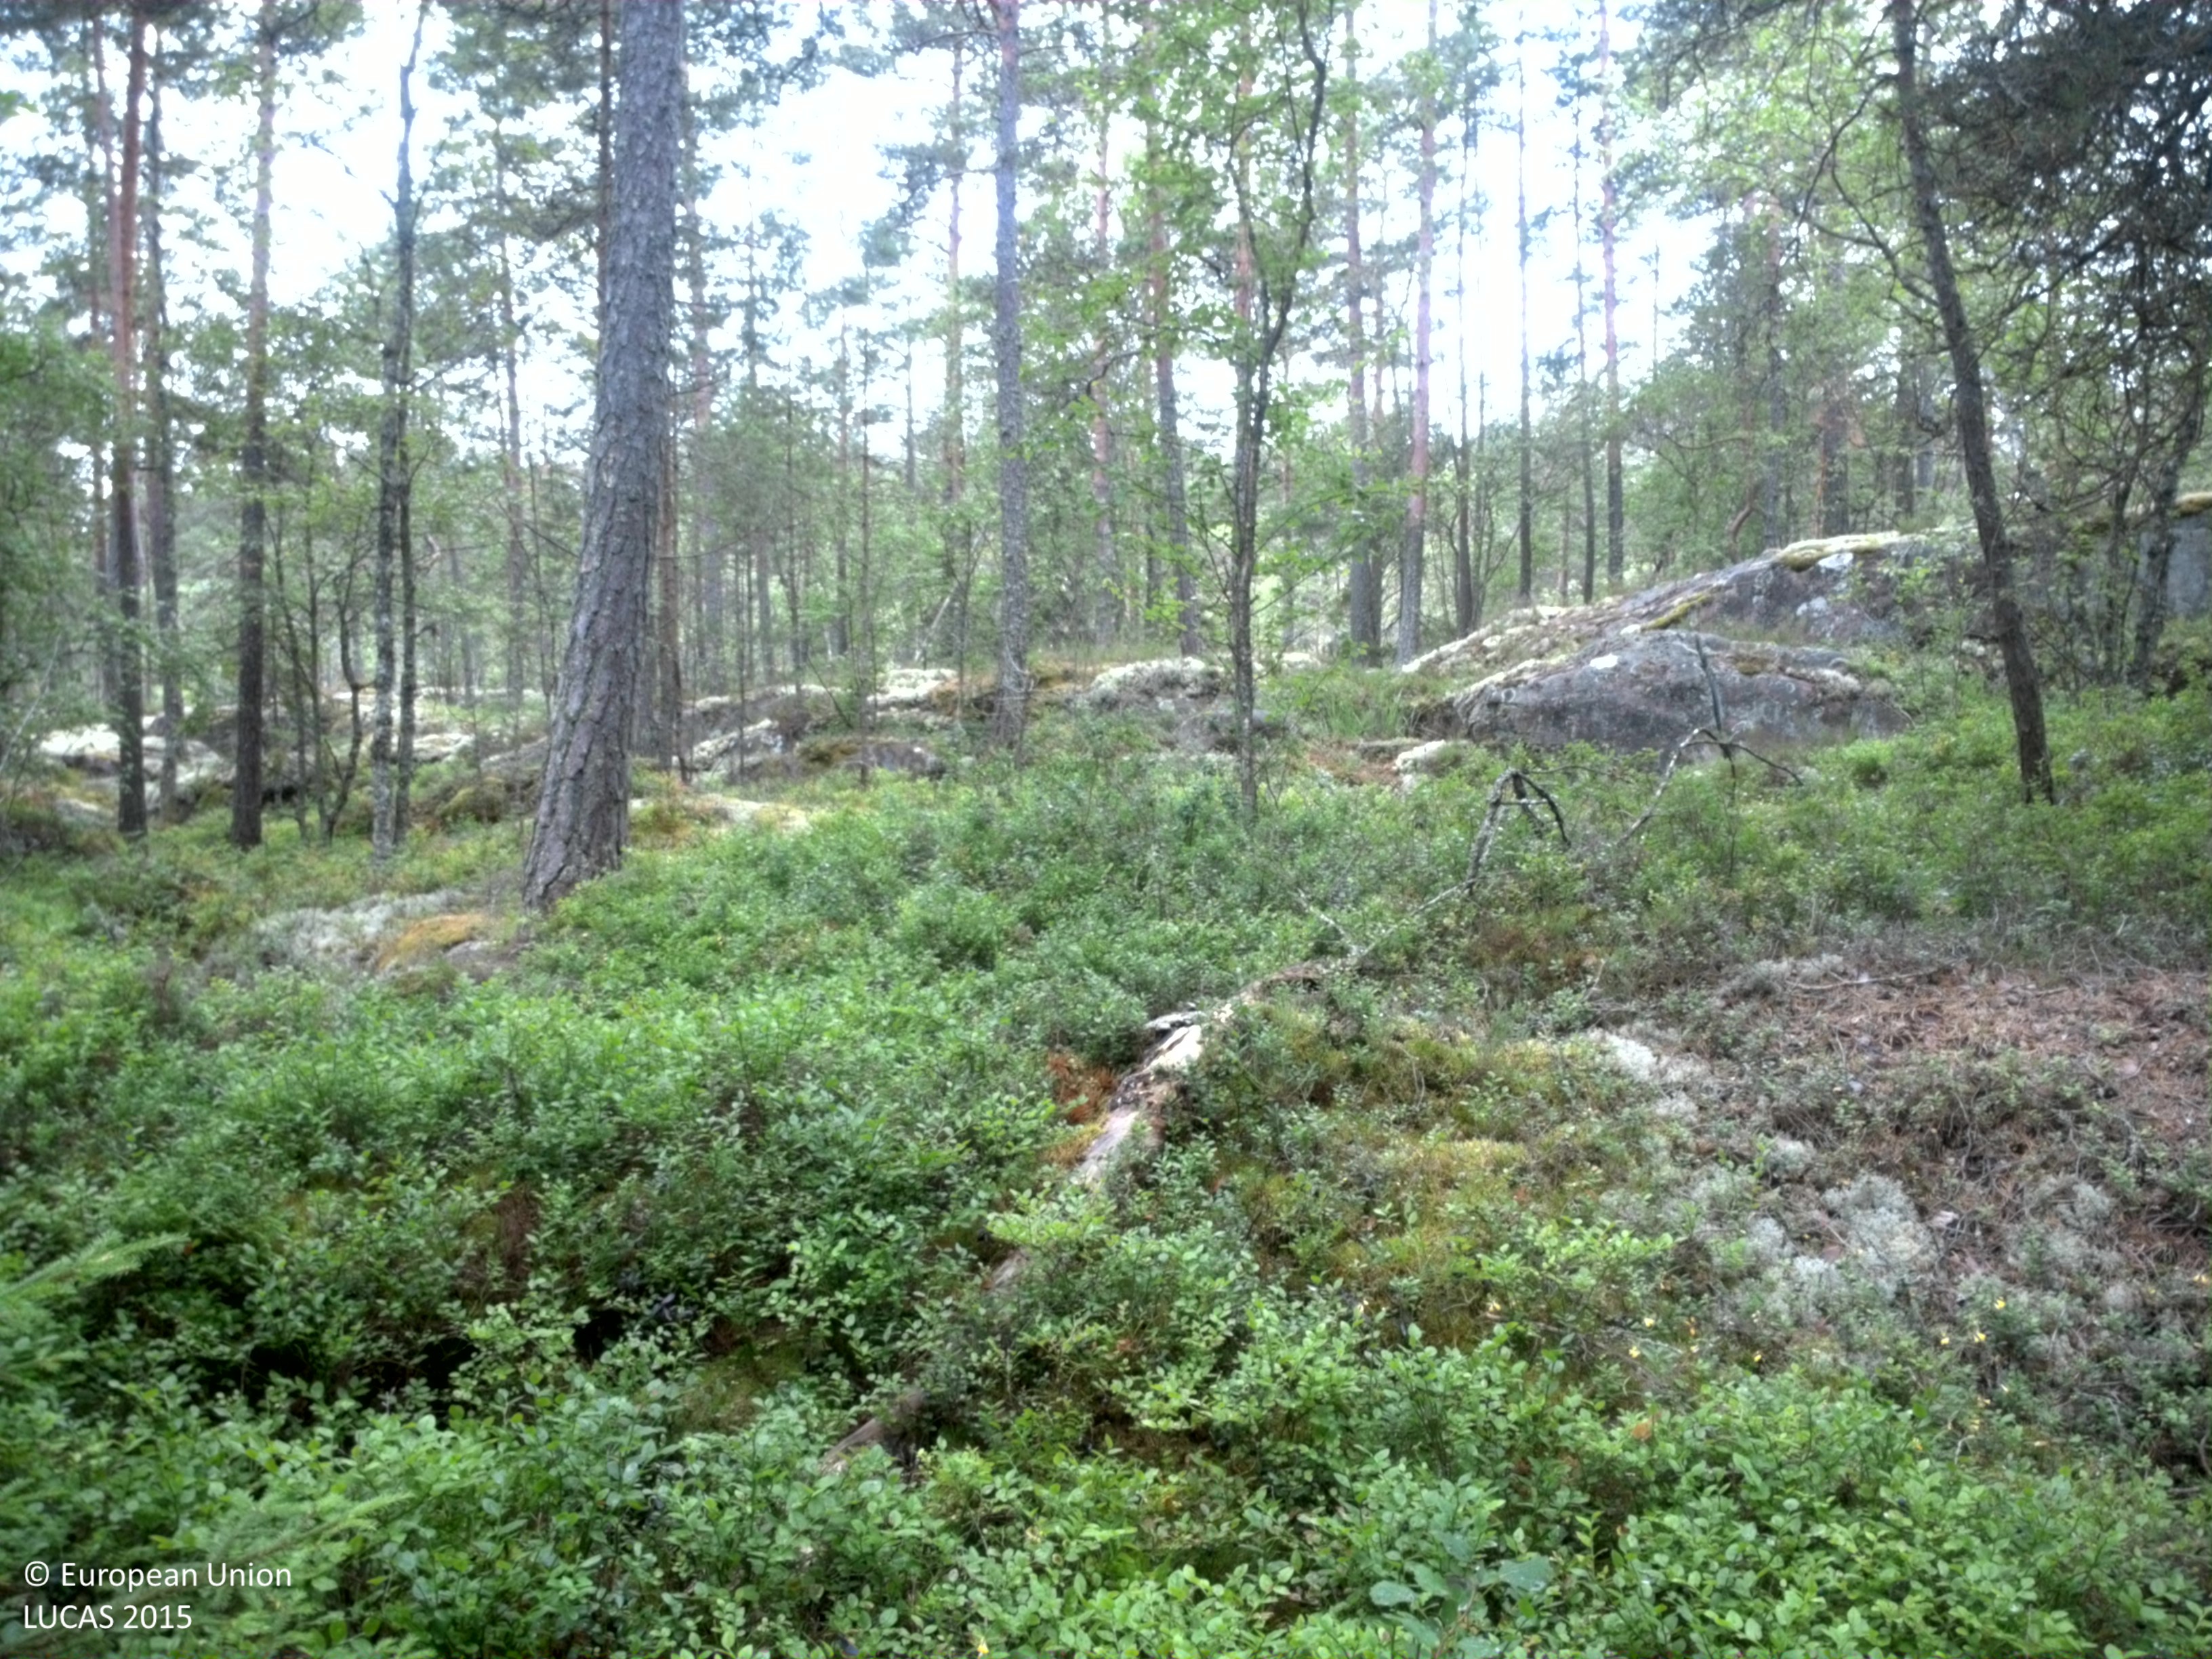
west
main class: Woodland
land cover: Pine dominated coniferous woodland
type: boreal forest
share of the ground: 50 - 75 %
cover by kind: coniferous forest trees 65 %, shrubs 20 %, lichens and mosses 10 %, broadleaved forest trees 5 %
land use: Forestry
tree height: > 5 m
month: July
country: SE
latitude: 59.3670
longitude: 13.3179
